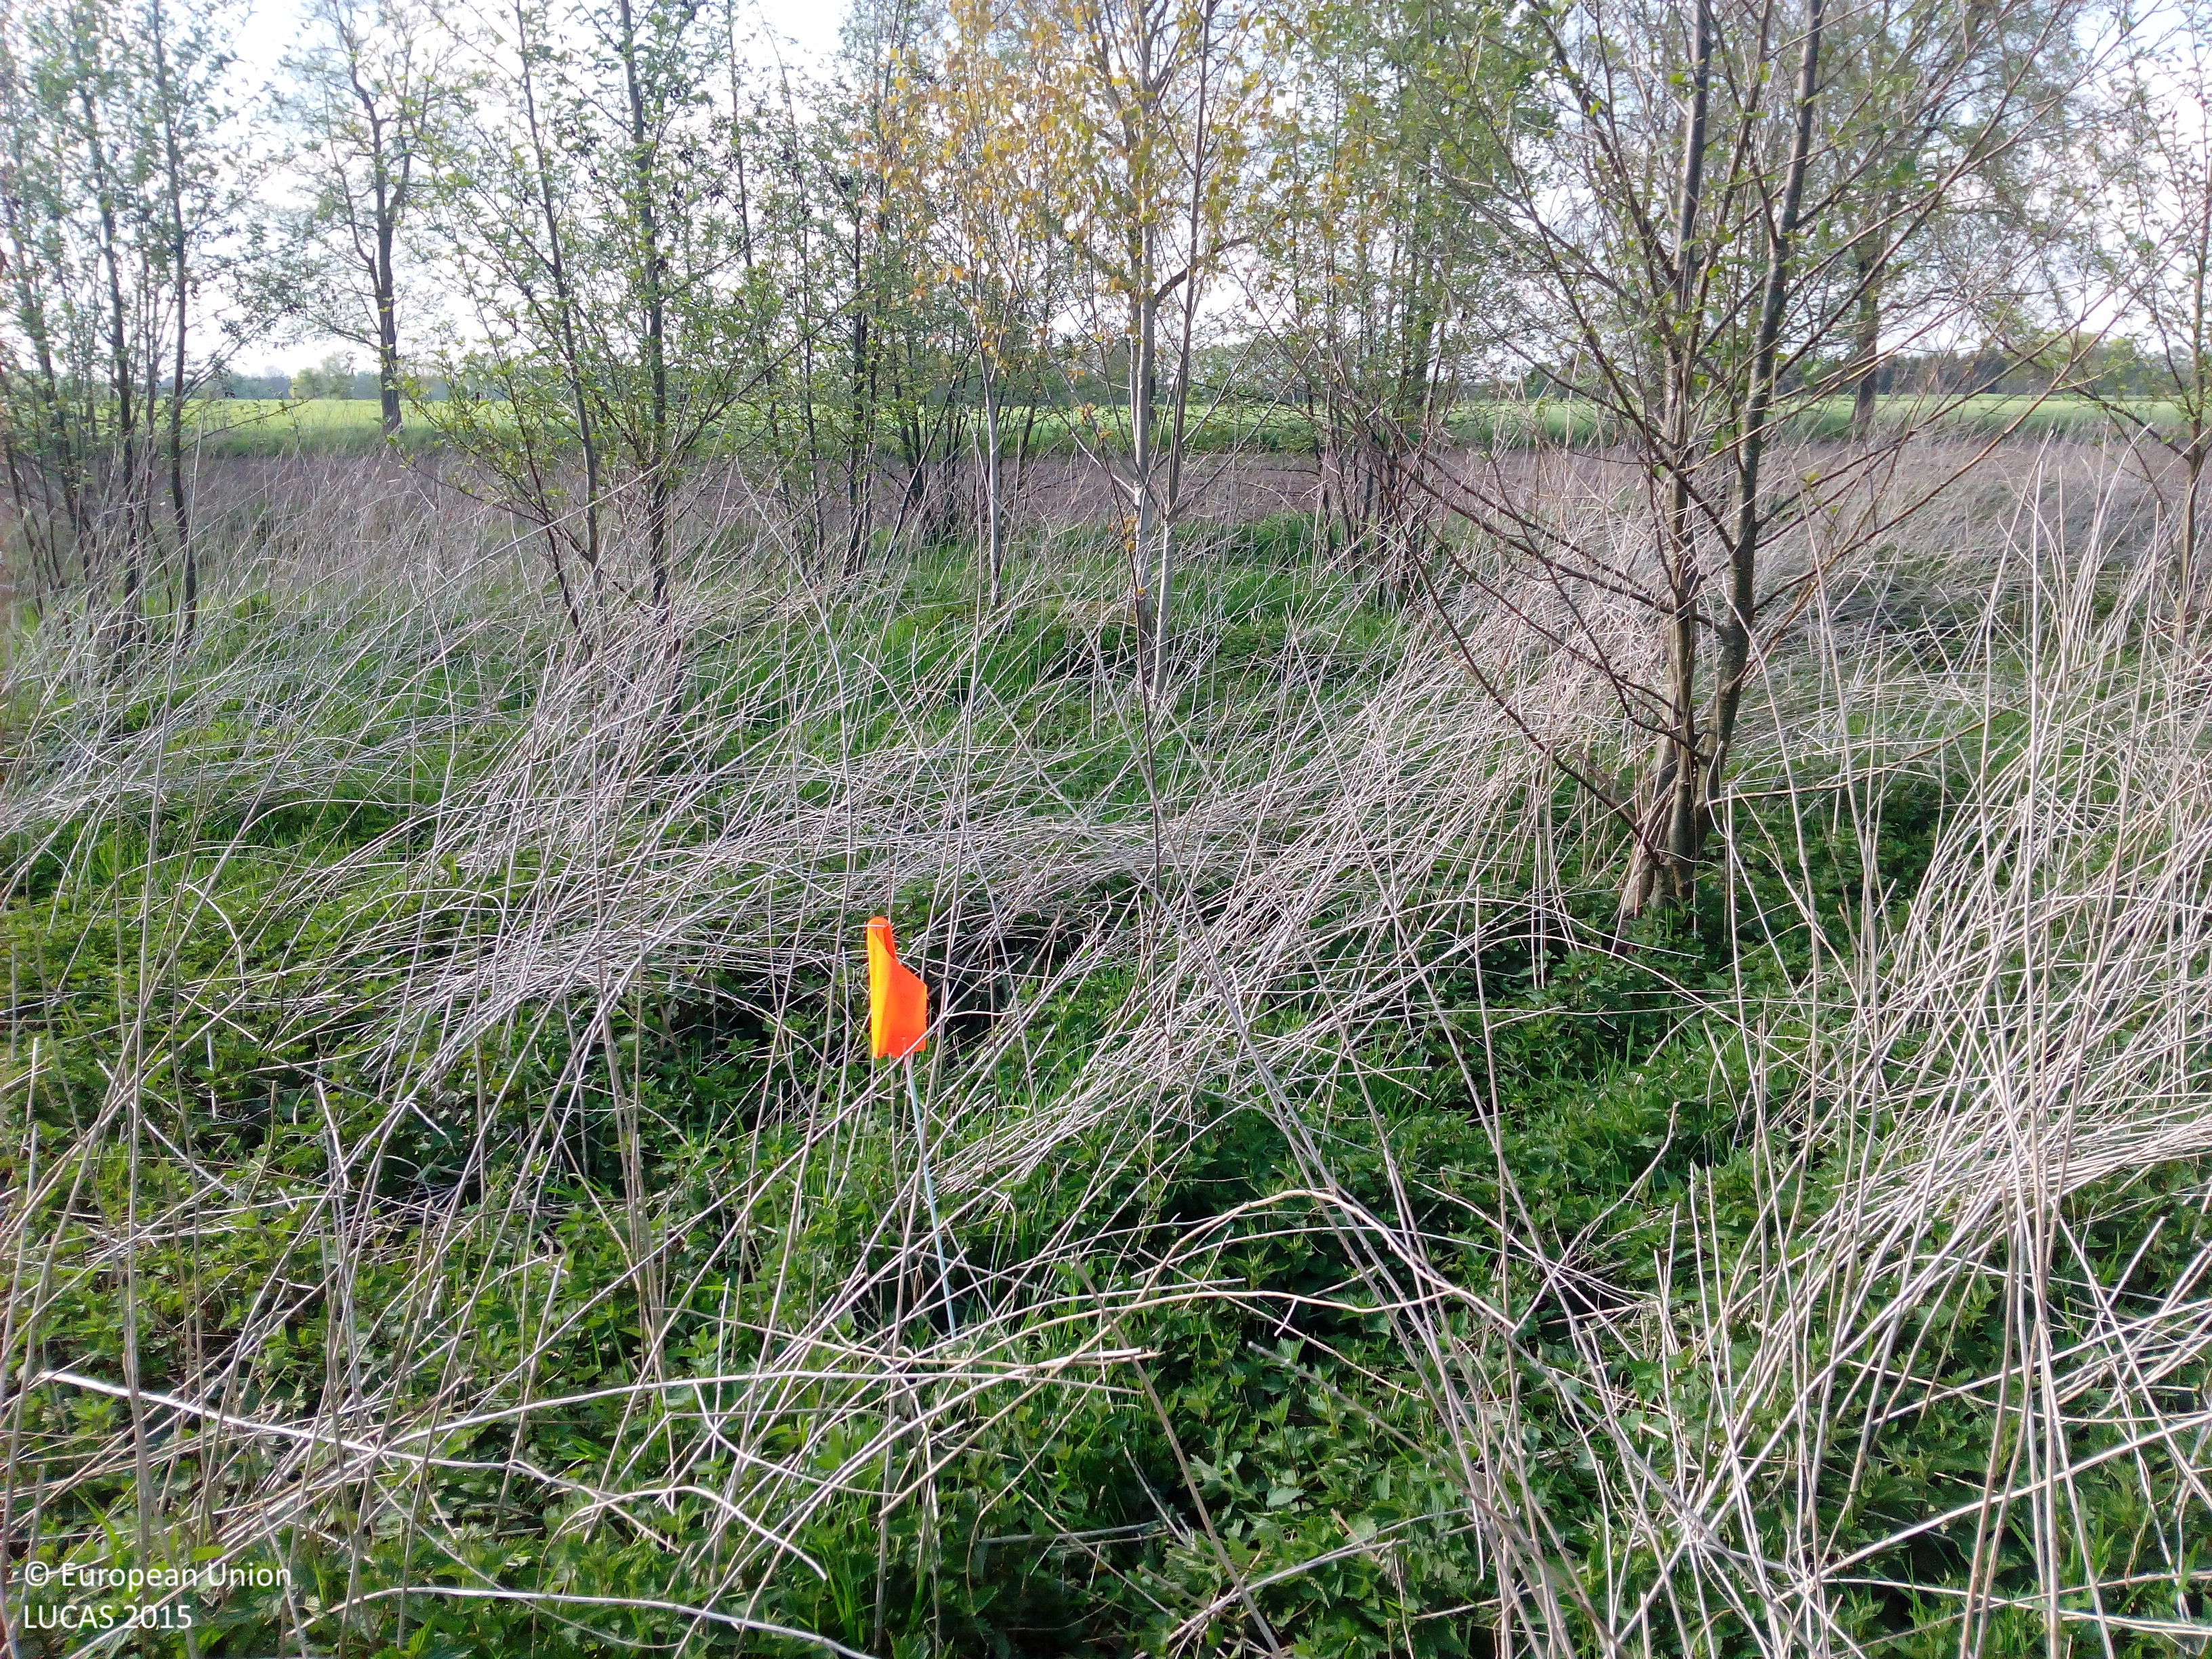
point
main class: Woodland
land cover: Broadleaved woodland
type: mesophytic deciduous forest
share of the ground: 10 - 25 %
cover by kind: herbaceous plants 80 %, broadleaved forest trees 20 %
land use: Forestry
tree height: > 5 m
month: May
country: DE
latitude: 52.1521
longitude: 7.4426
